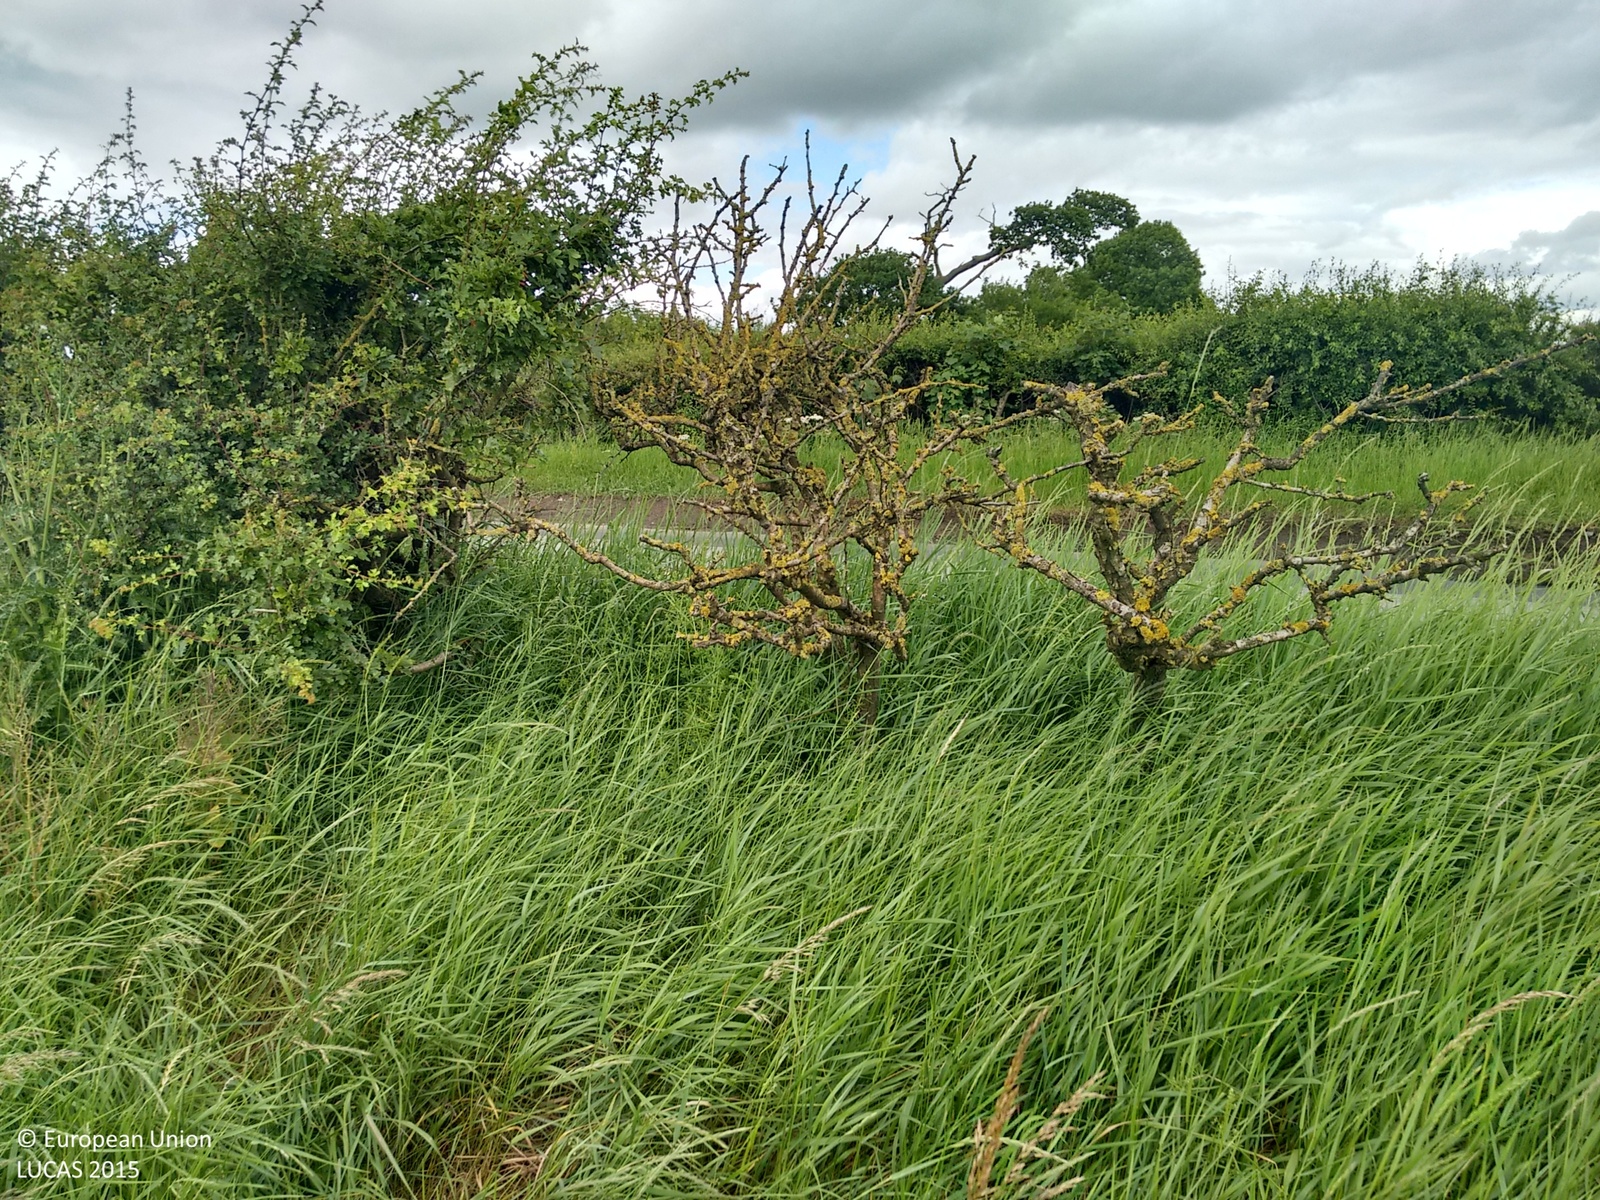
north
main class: Cropland
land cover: Barley
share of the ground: > 75 %
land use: Agriculture (excluding fallow land and kitchen gardens)
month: July
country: GB
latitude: 54.5947
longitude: -1.5171
